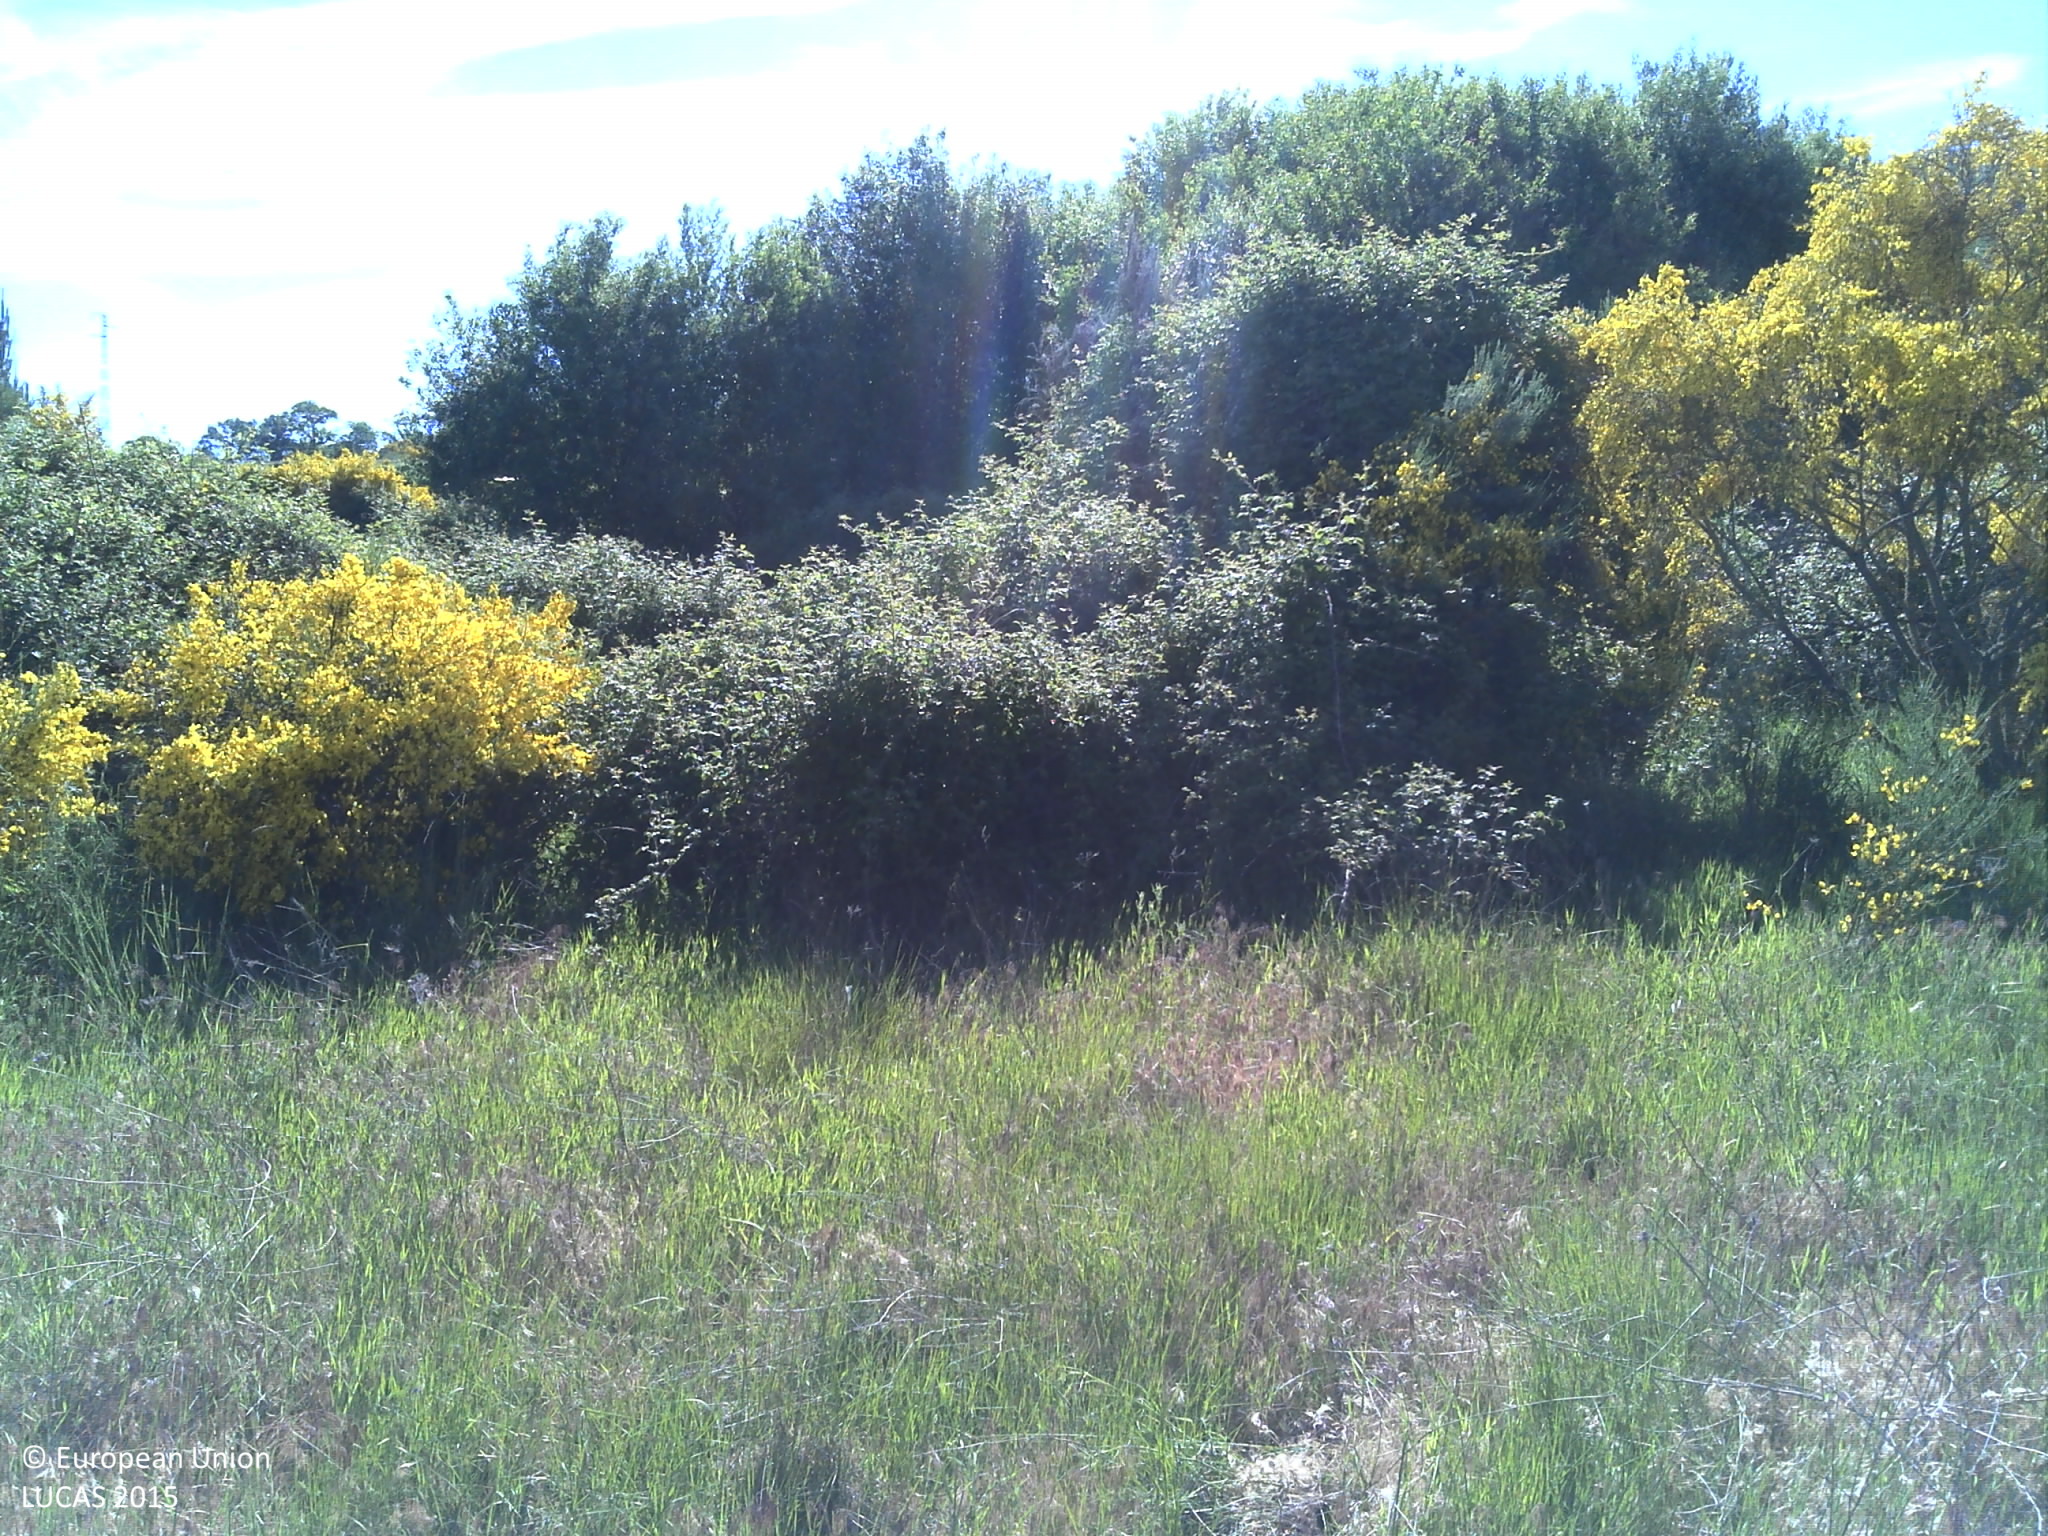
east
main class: Shrubland
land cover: Shrubland without tree cover
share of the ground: 25 - 50 %
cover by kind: herbaceous plants 70 %, shrubs 30 %
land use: Forestry
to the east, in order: Shrubland without tree cover; Shrubland with sparse tree cover; Shruby margins; Tracks; Nuts trees; Electric lines; Grass margins; Tracks; Dry stone walls; Lines of trees; Ditches and canals; Shrubland with sparse tree cover; Shrubland without tree cover
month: May
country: PT
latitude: 41.7671
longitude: -7.3654
